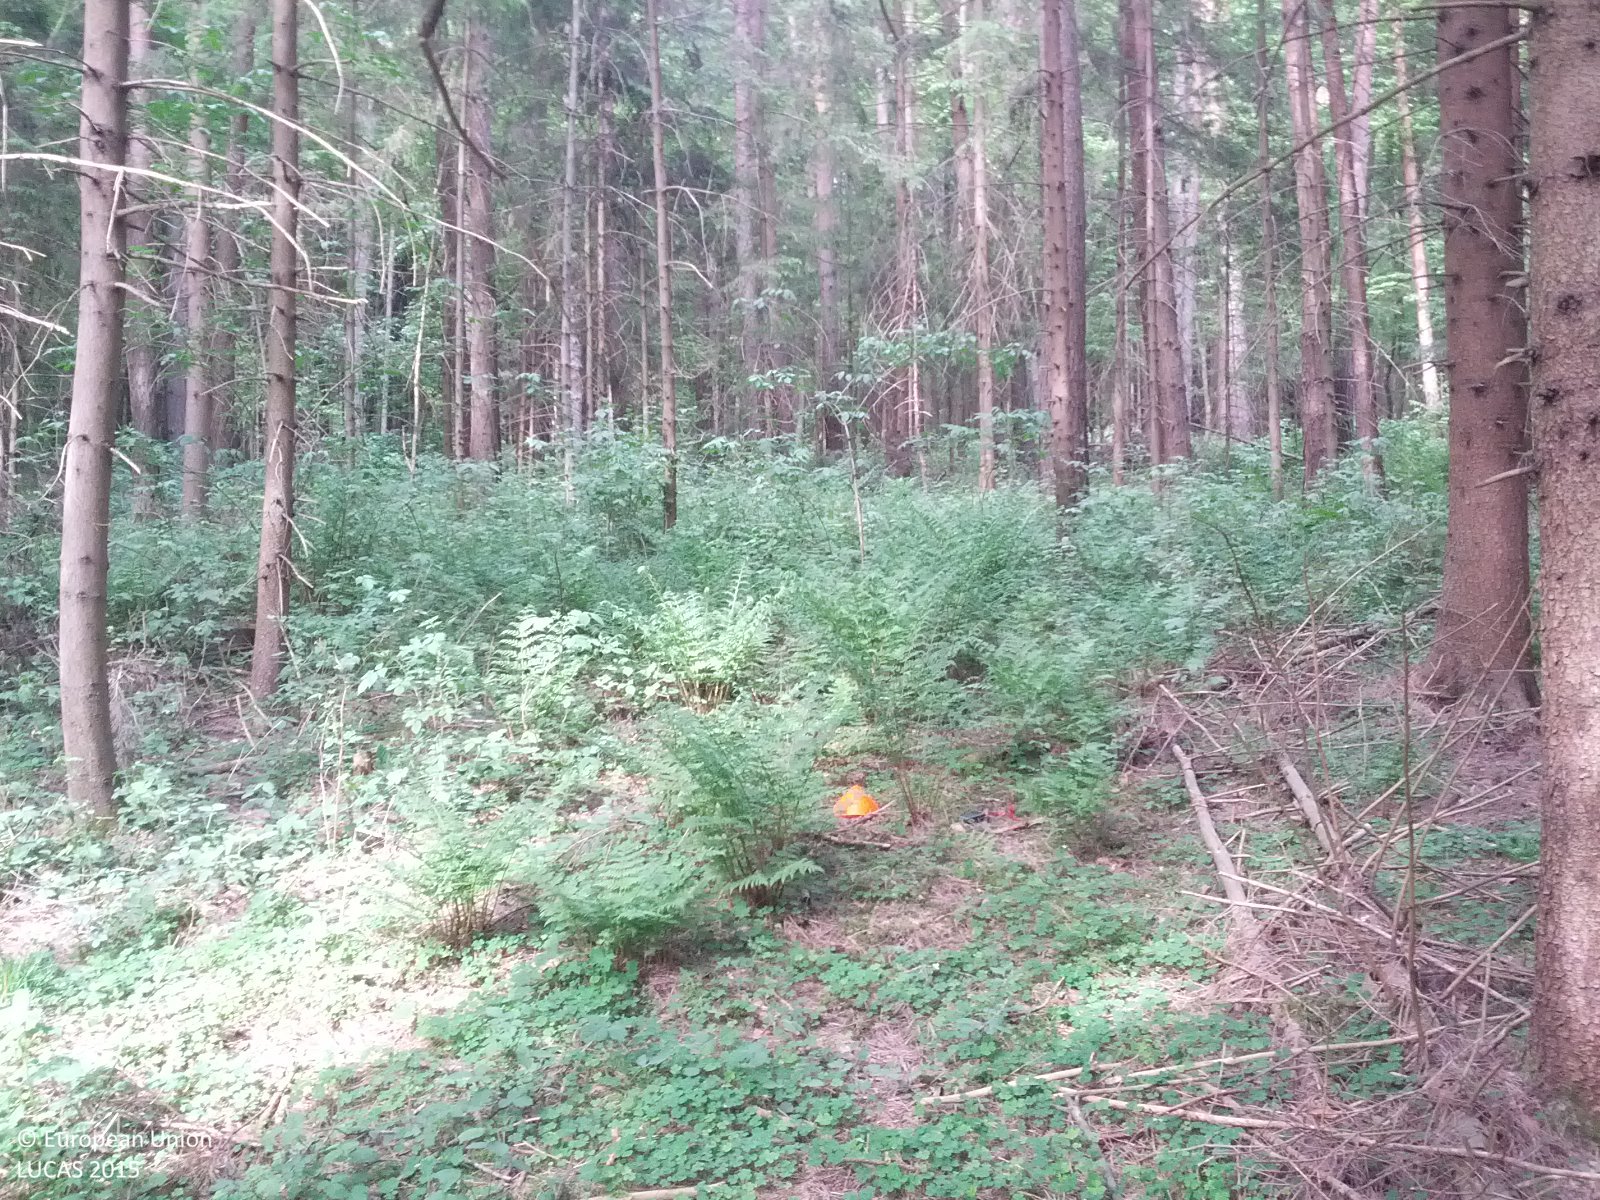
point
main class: Woodland
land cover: Pine dominated coniferous woodland
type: hemiboreal forest and nemoral coniferous forest and mixed broadleaved-coniferous forest
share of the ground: > 75 %
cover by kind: coniferous forest trees 70 %, broadleaved forest trees 10 %, herbaceous plants 10 %, shrubs 5 %, lichens and mosses 5 %
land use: Forestry
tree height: > 5 m
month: May
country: AT
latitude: 47.3505
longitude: 16.1048
